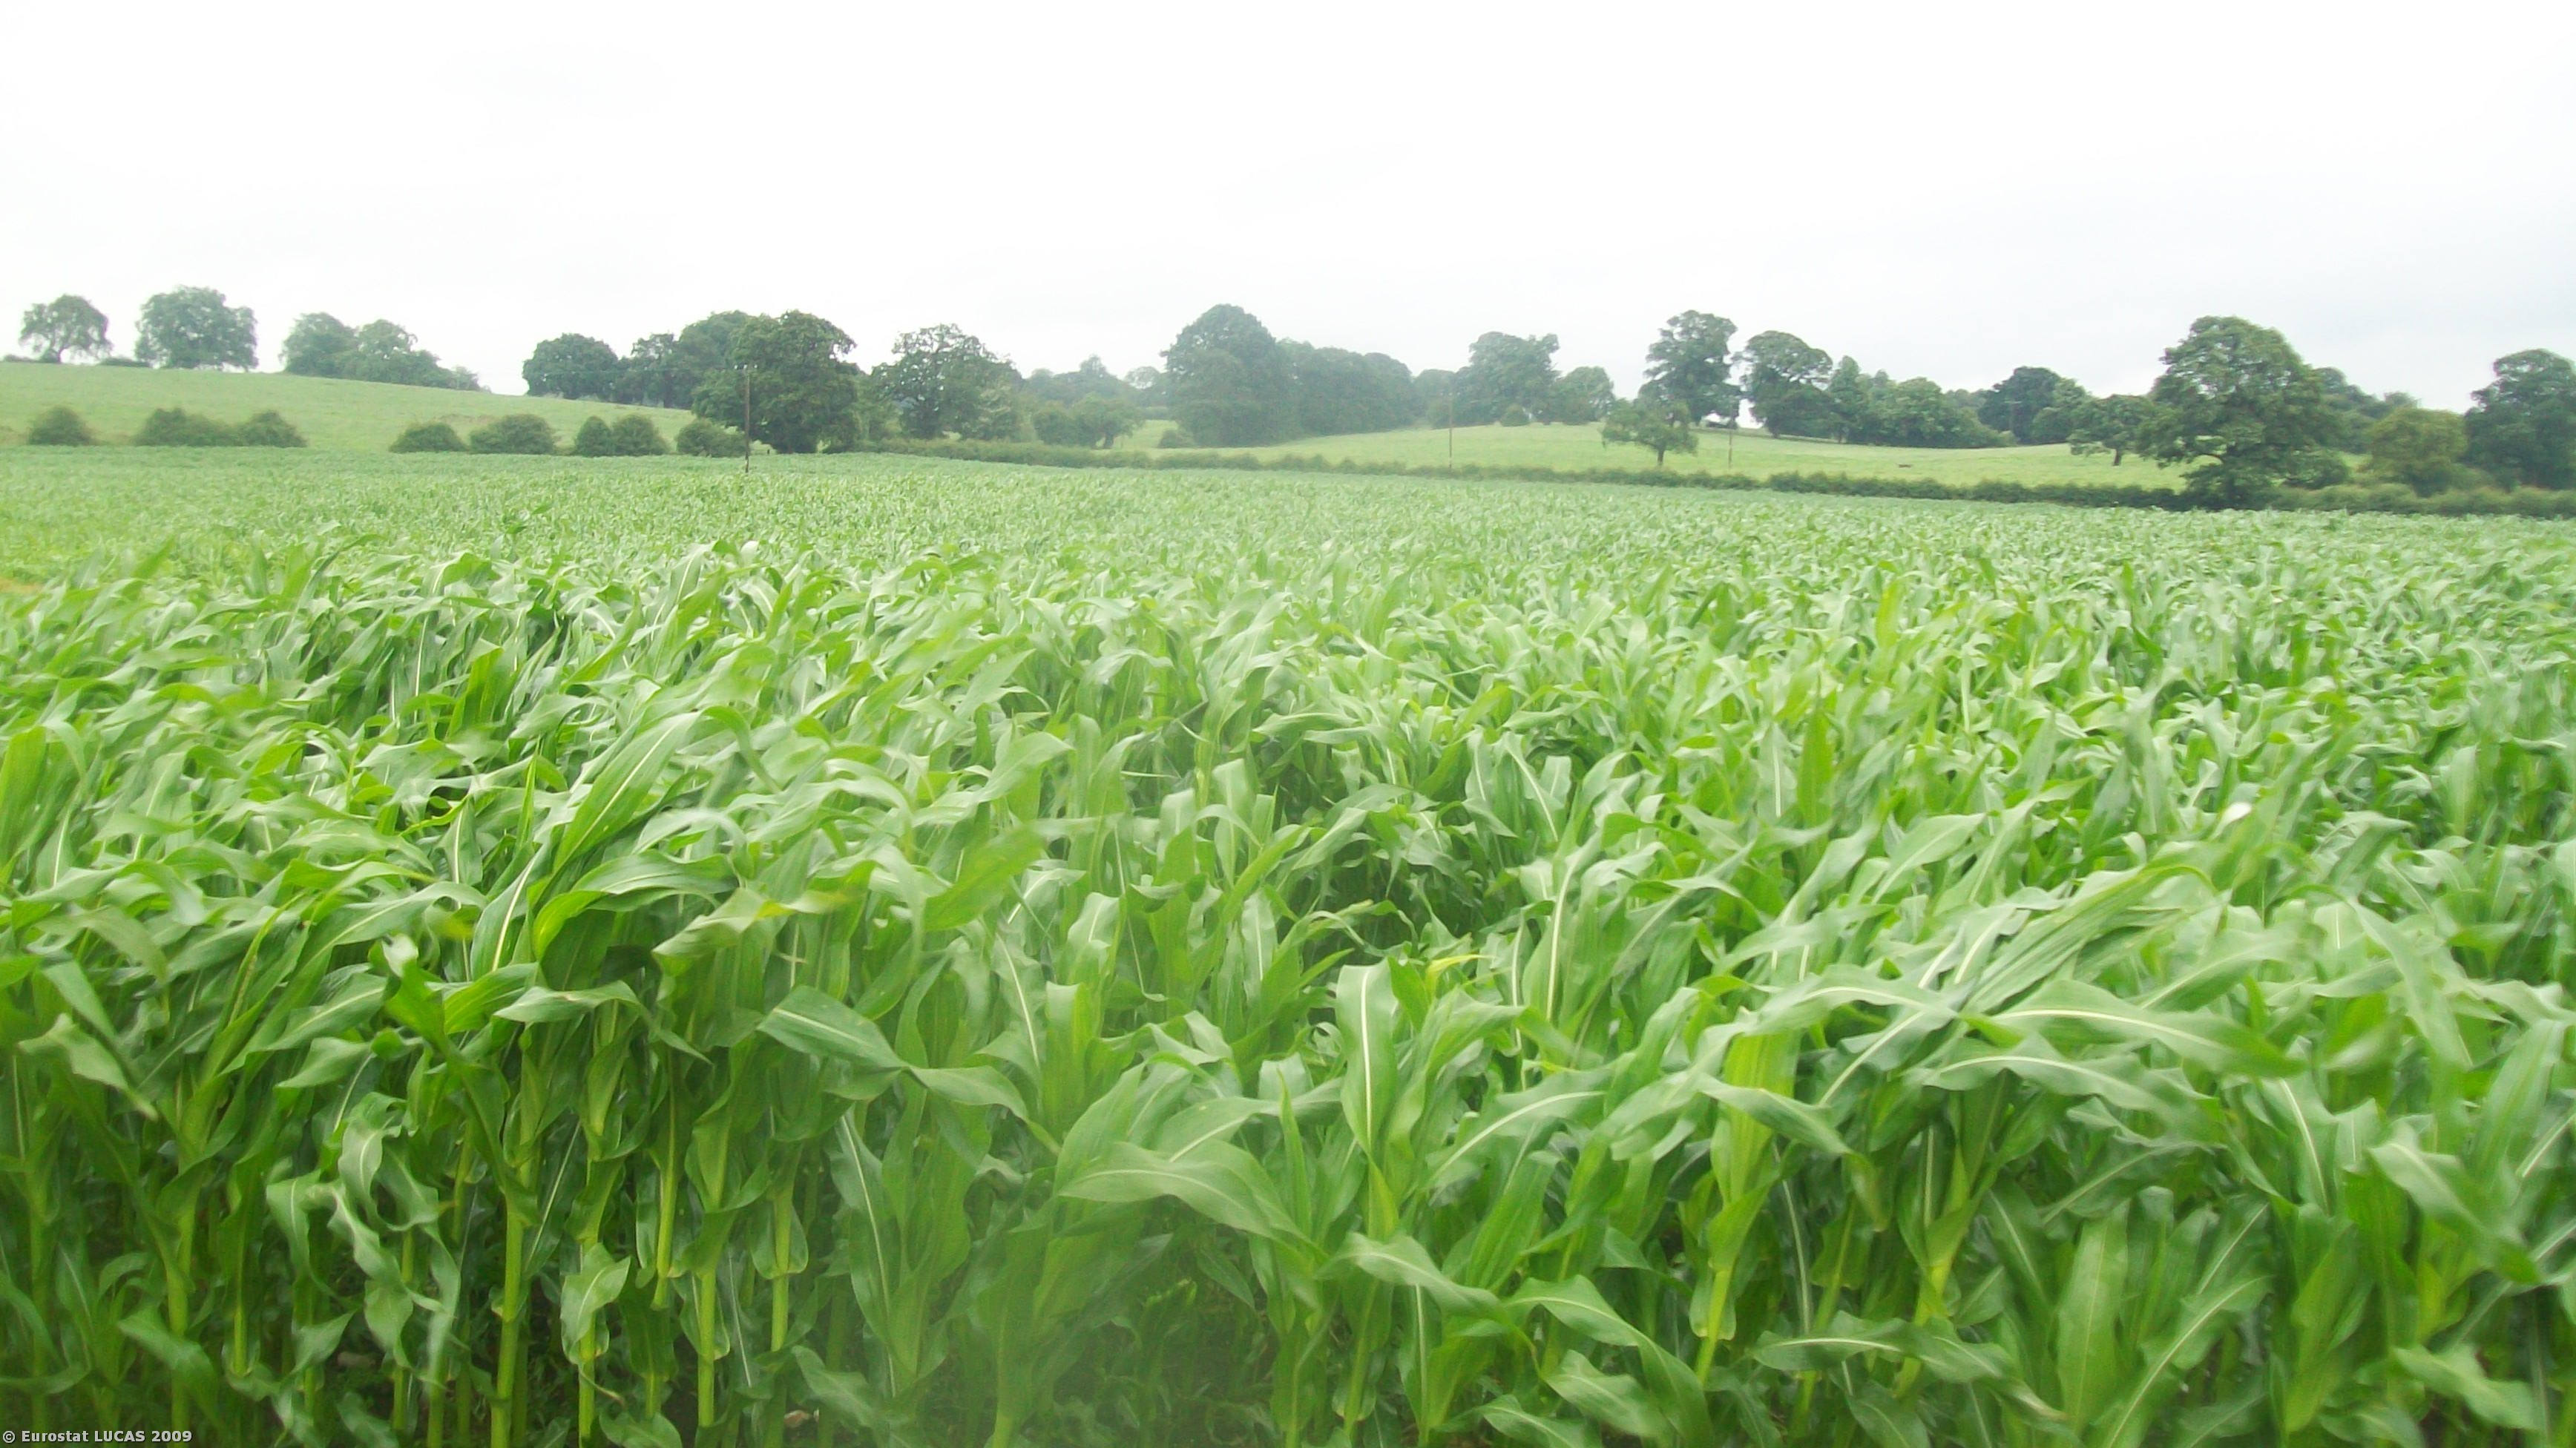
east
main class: Cropland
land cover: Maize
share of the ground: > 75 %
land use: Agriculture (excluding fallow land and kitchen gardens)
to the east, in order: Maize; Managed hedges; Grassland without tree/shrub cover
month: July
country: GB
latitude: 52.9717
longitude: -2.6513
